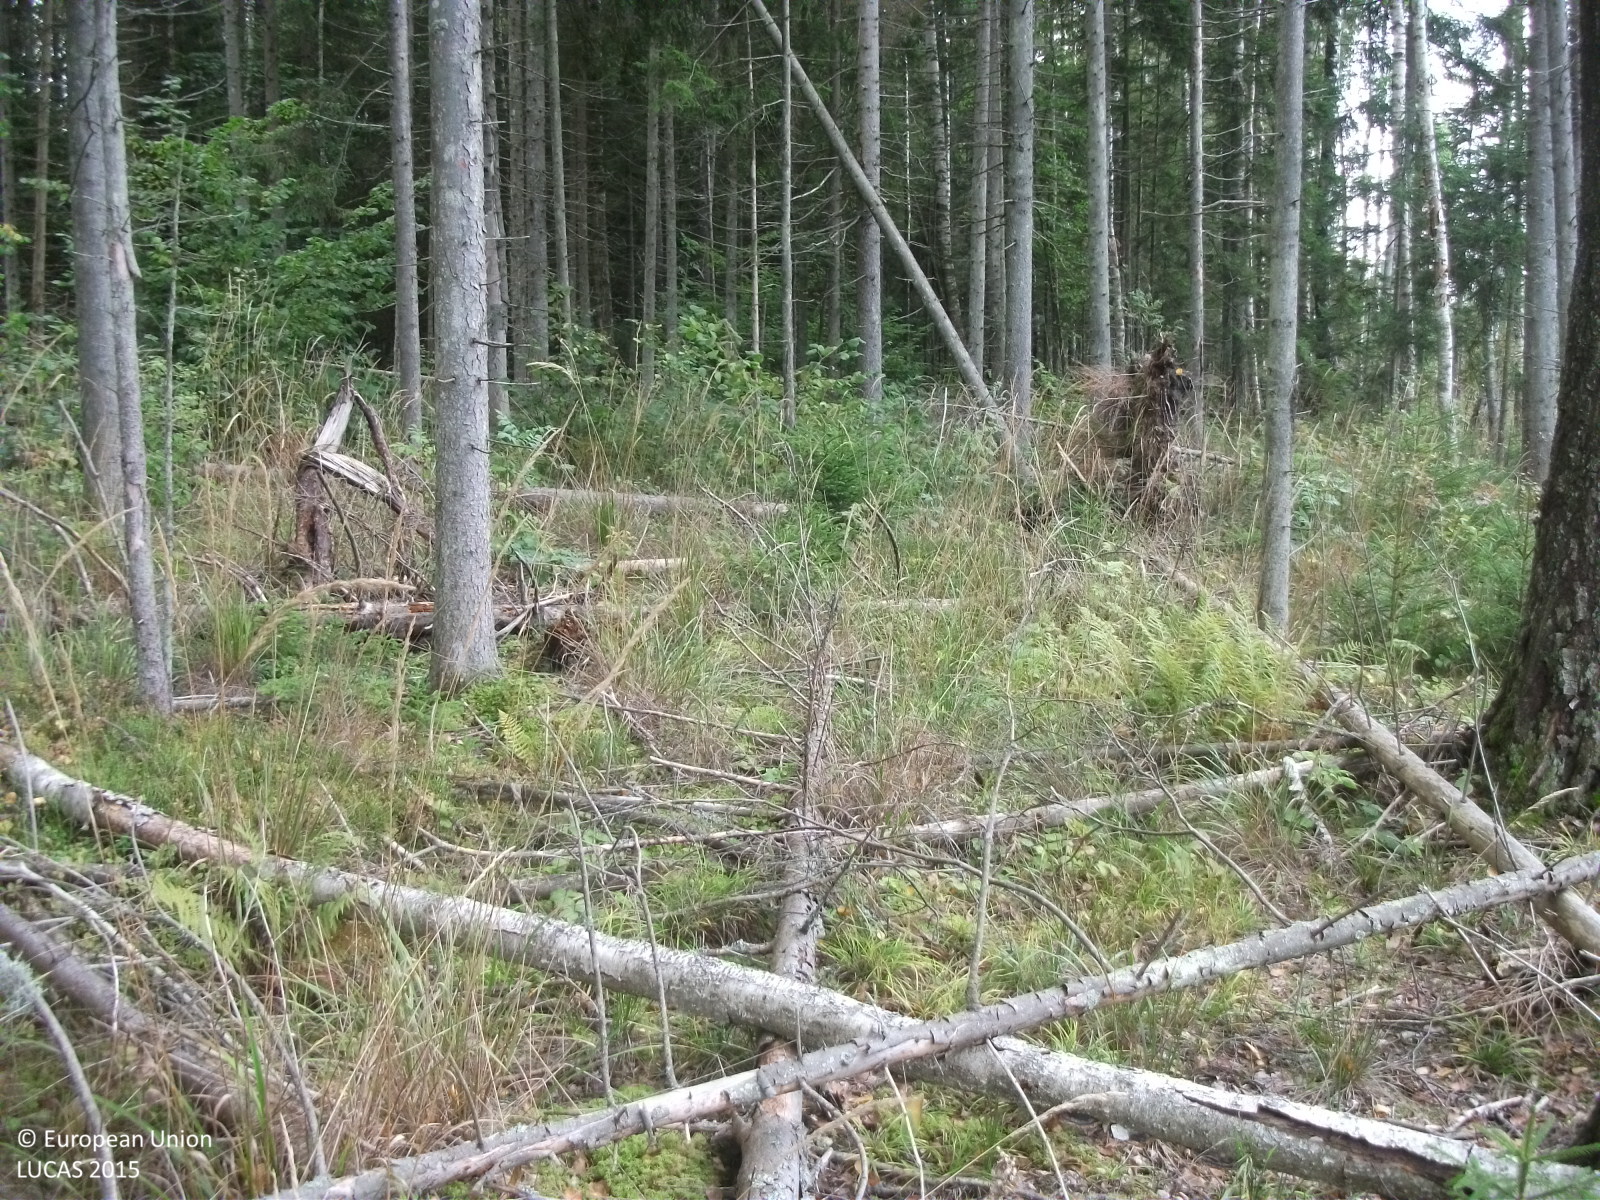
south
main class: Woodland
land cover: Spruce dominated mixed woodland
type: hemiboreal forest and nemoral coniferous forest and mixed broadleaved-coniferous forest
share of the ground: > 75 %
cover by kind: coniferous forest trees 50 %, broadleaved forest trees 30 %, herbaceous plants 10 %, shrubs 5 %
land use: Forestry
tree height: > 5 m
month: September
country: LV
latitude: 57.7826
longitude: 24.4332
